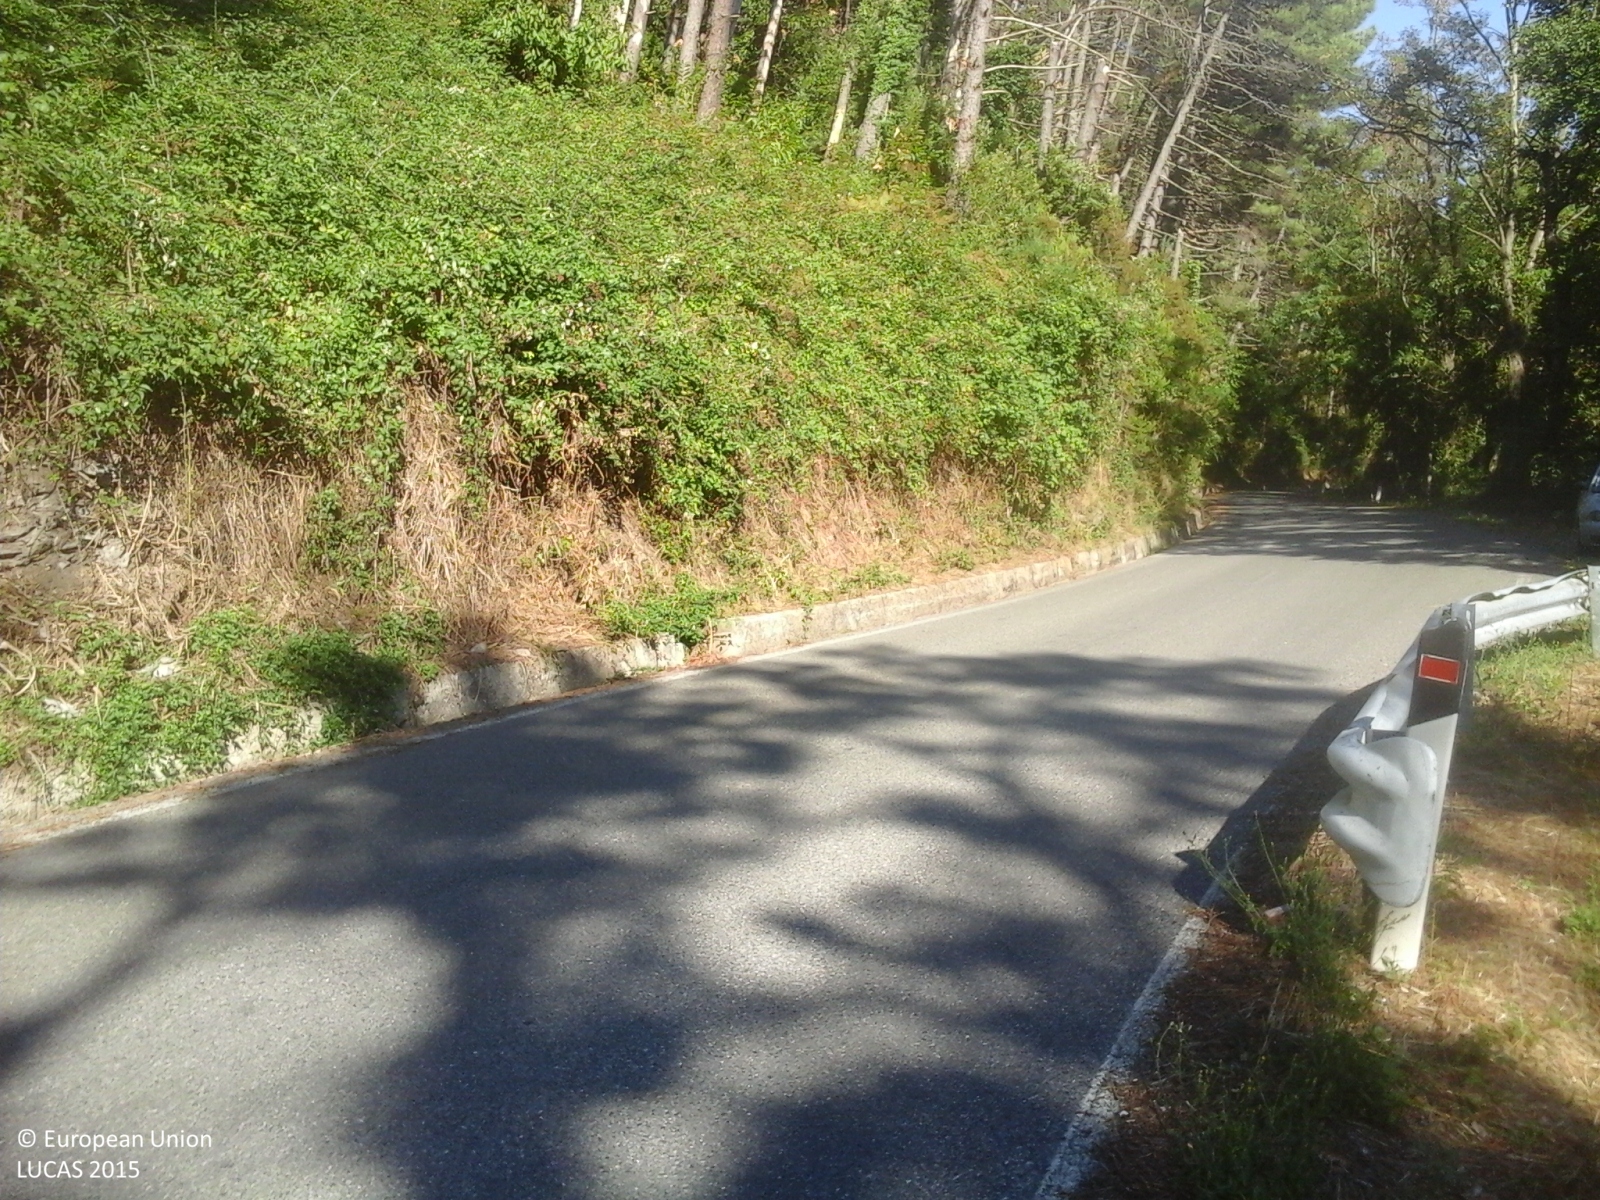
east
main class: Woodland
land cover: Pine dominated coniferous woodland
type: coniferous forest of the mediterranean region
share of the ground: > 75 %
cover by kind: coniferous forest trees 100 %
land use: Forestry
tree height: > 5 m
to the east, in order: Pine dominated coniferous woodland; Grass margins; Paved roads, cycling and walking lanes; Grass margins; Pine dominated coniferous woodland
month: August
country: IT
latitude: 43.7357
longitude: 10.5572
